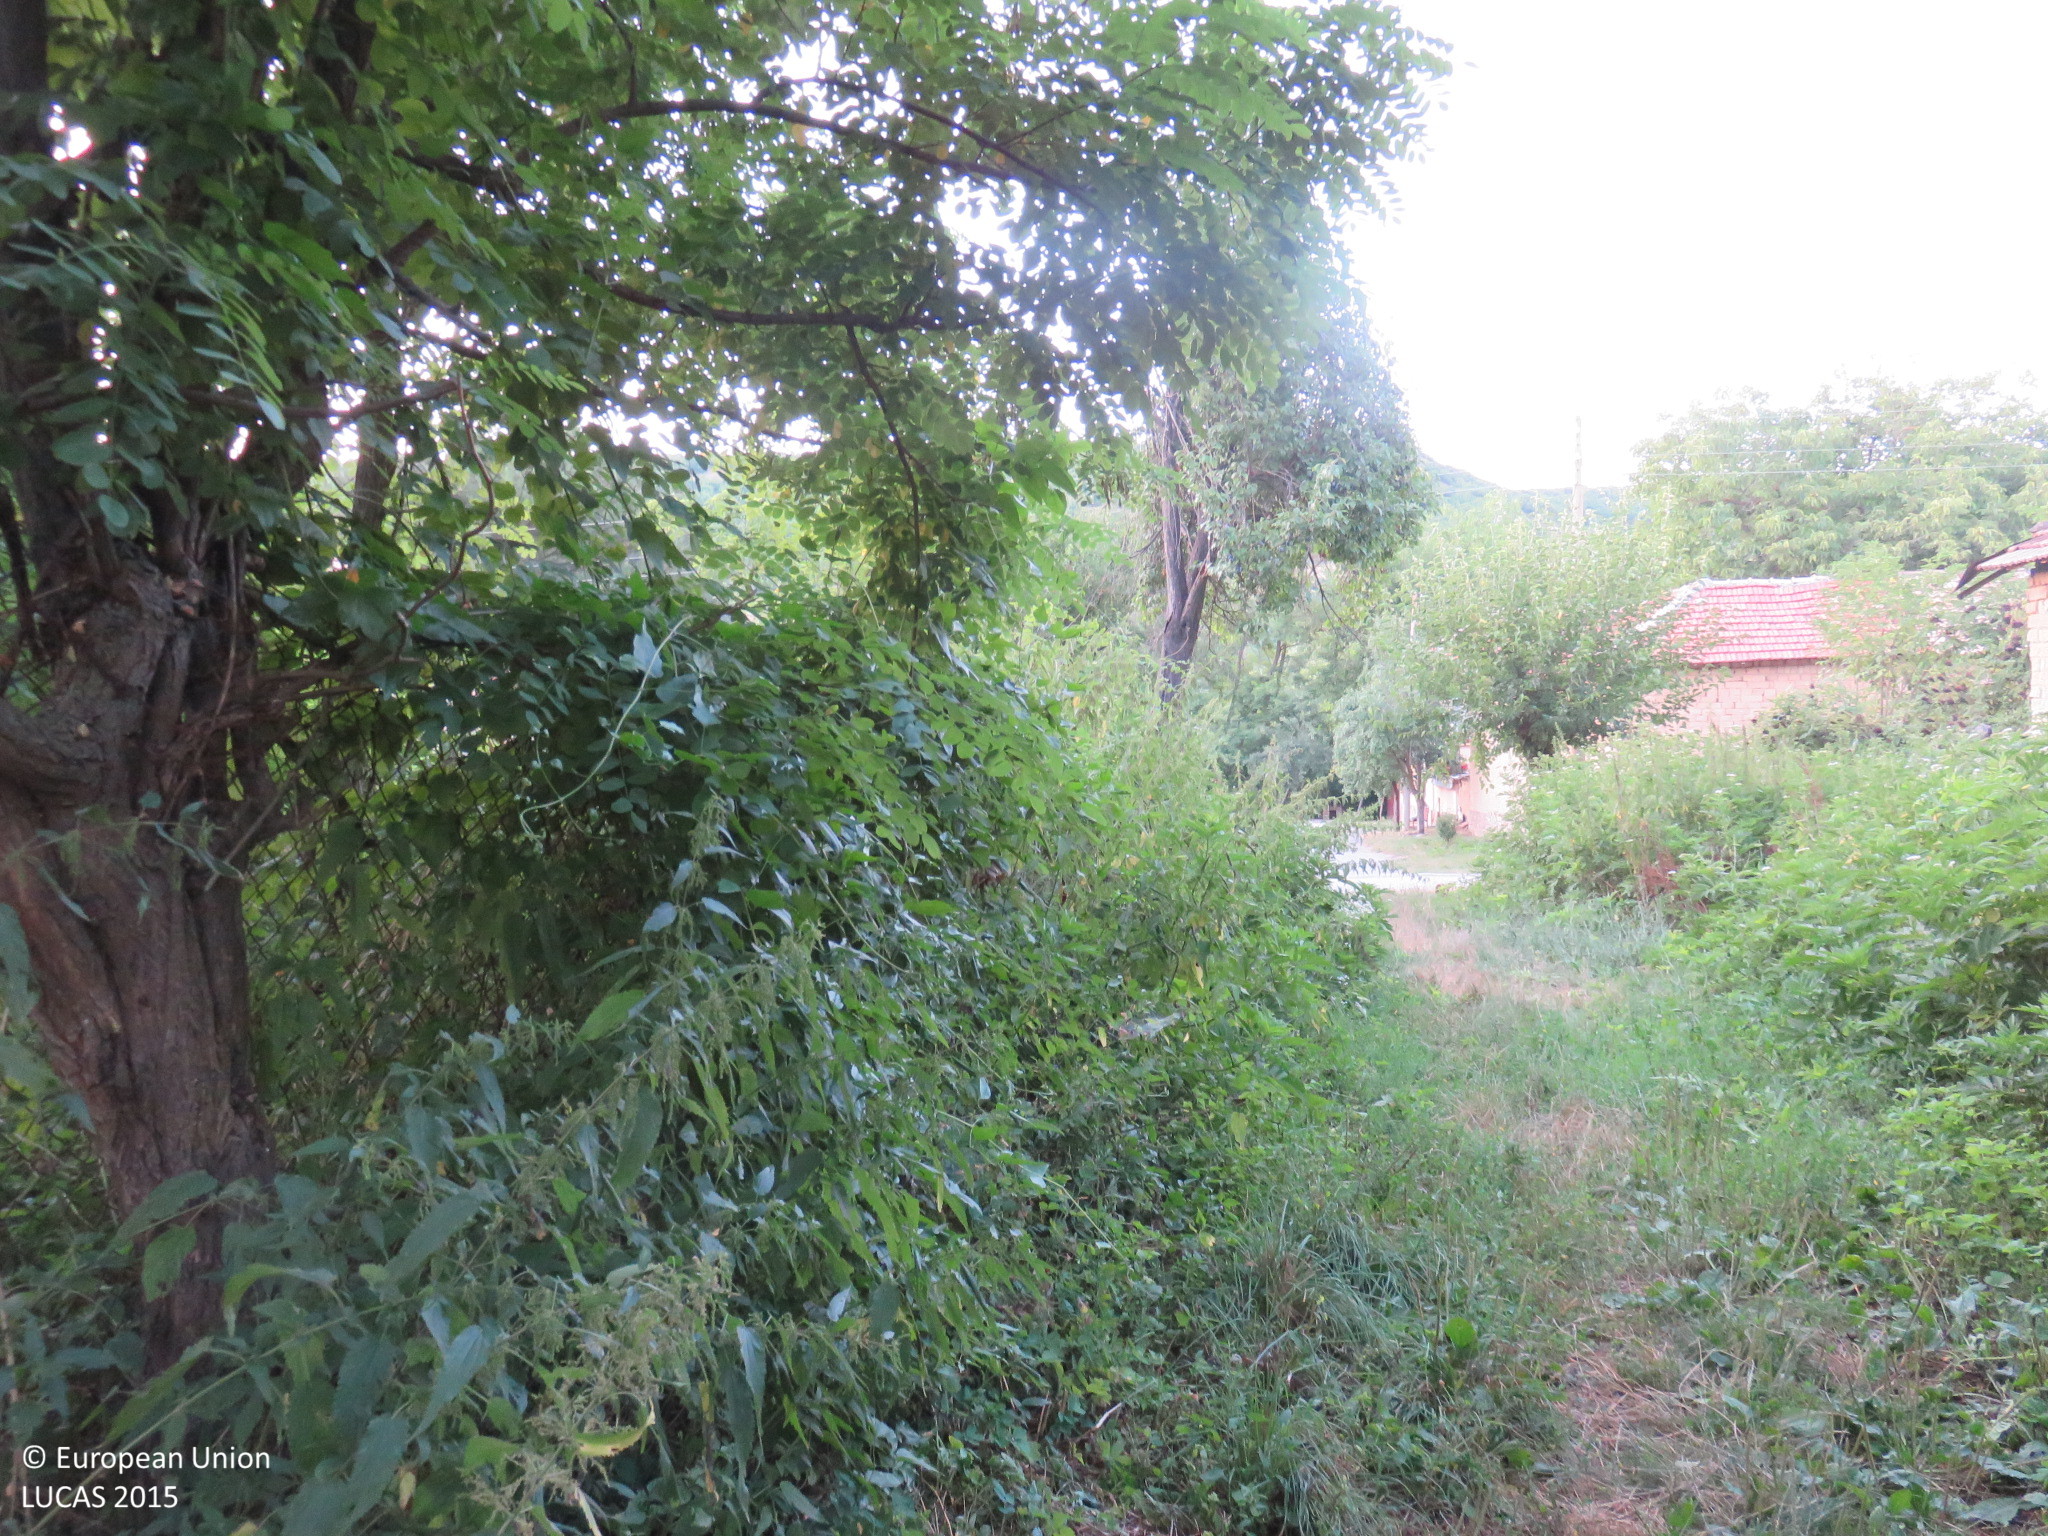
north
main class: Woodland
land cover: Broadleaved woodland
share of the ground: 25 - 50 %
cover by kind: herbaceous plants 60 %, broadleaved forest trees 35 %, shrubs 5 %
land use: Residential
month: July
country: BG
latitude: 43.1308
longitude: 25.2038
